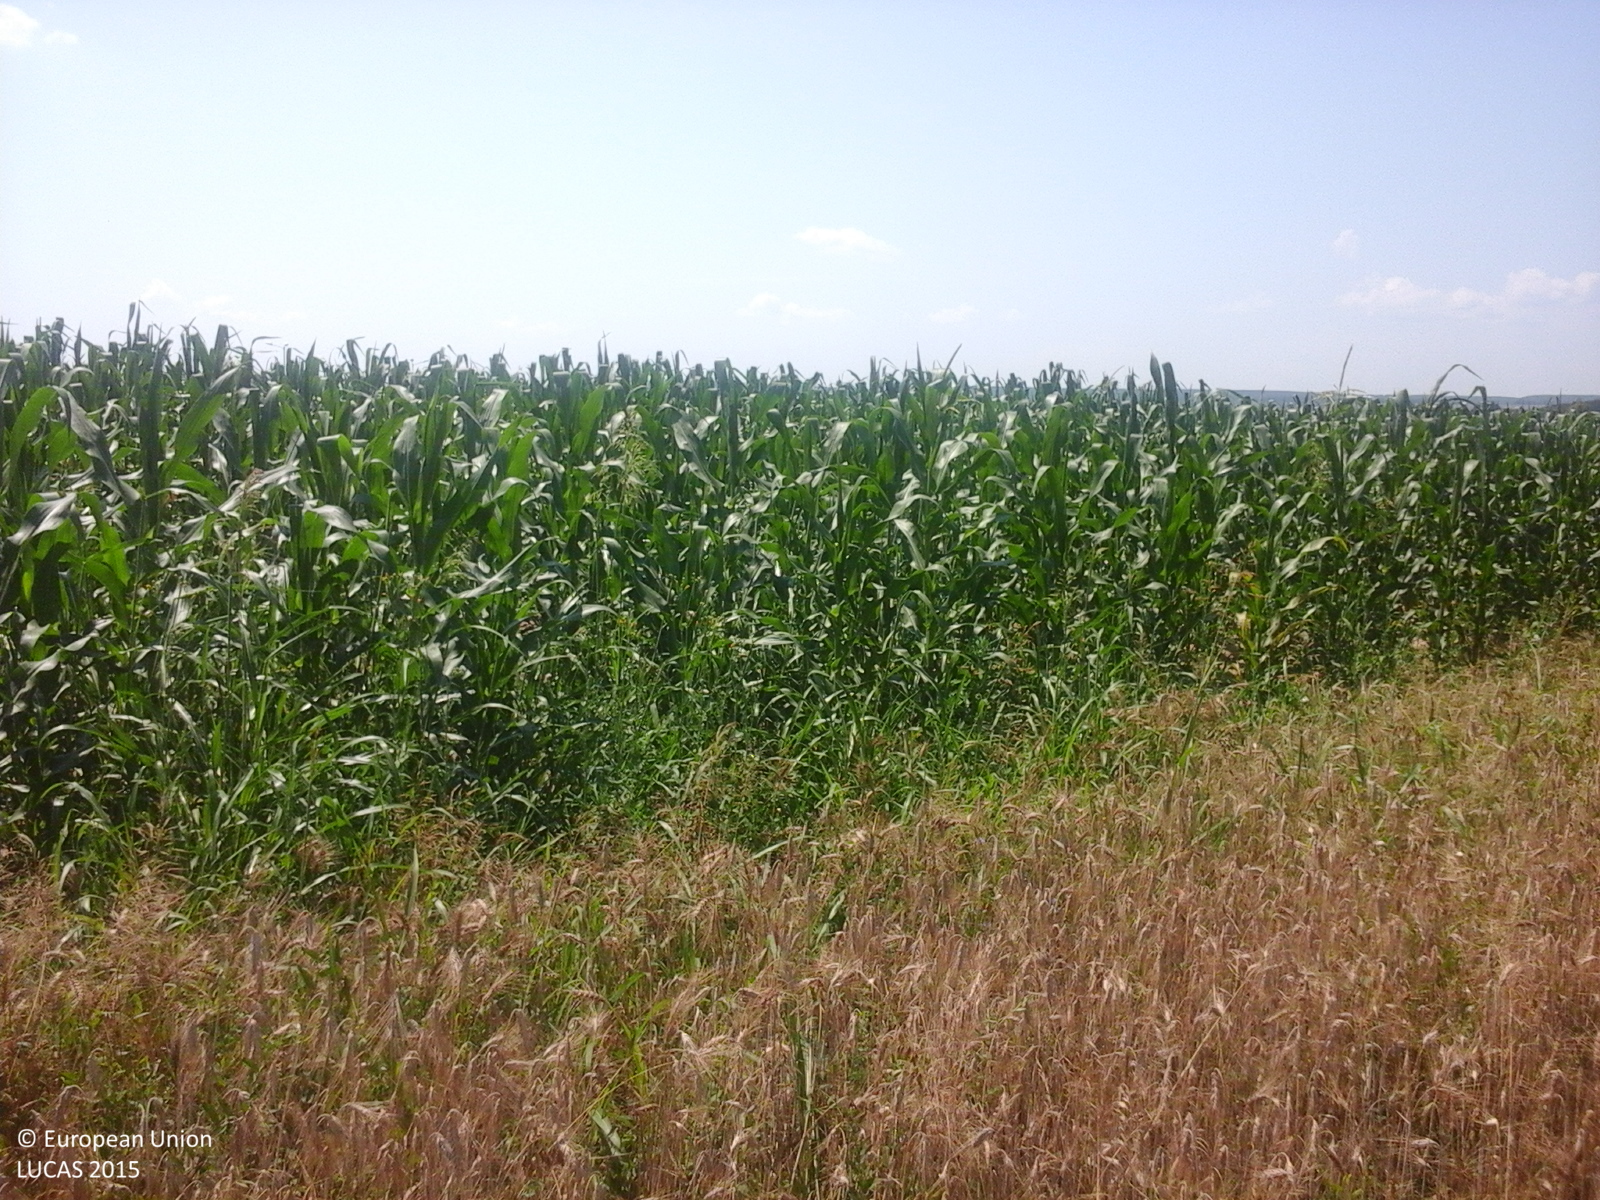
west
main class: Cropland
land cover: Common wheat
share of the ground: > 75 %
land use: Agriculture (excluding fallow land and kitchen gardens)
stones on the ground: < 10 %
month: July
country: RO
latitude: 44.9665
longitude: 24.9303
